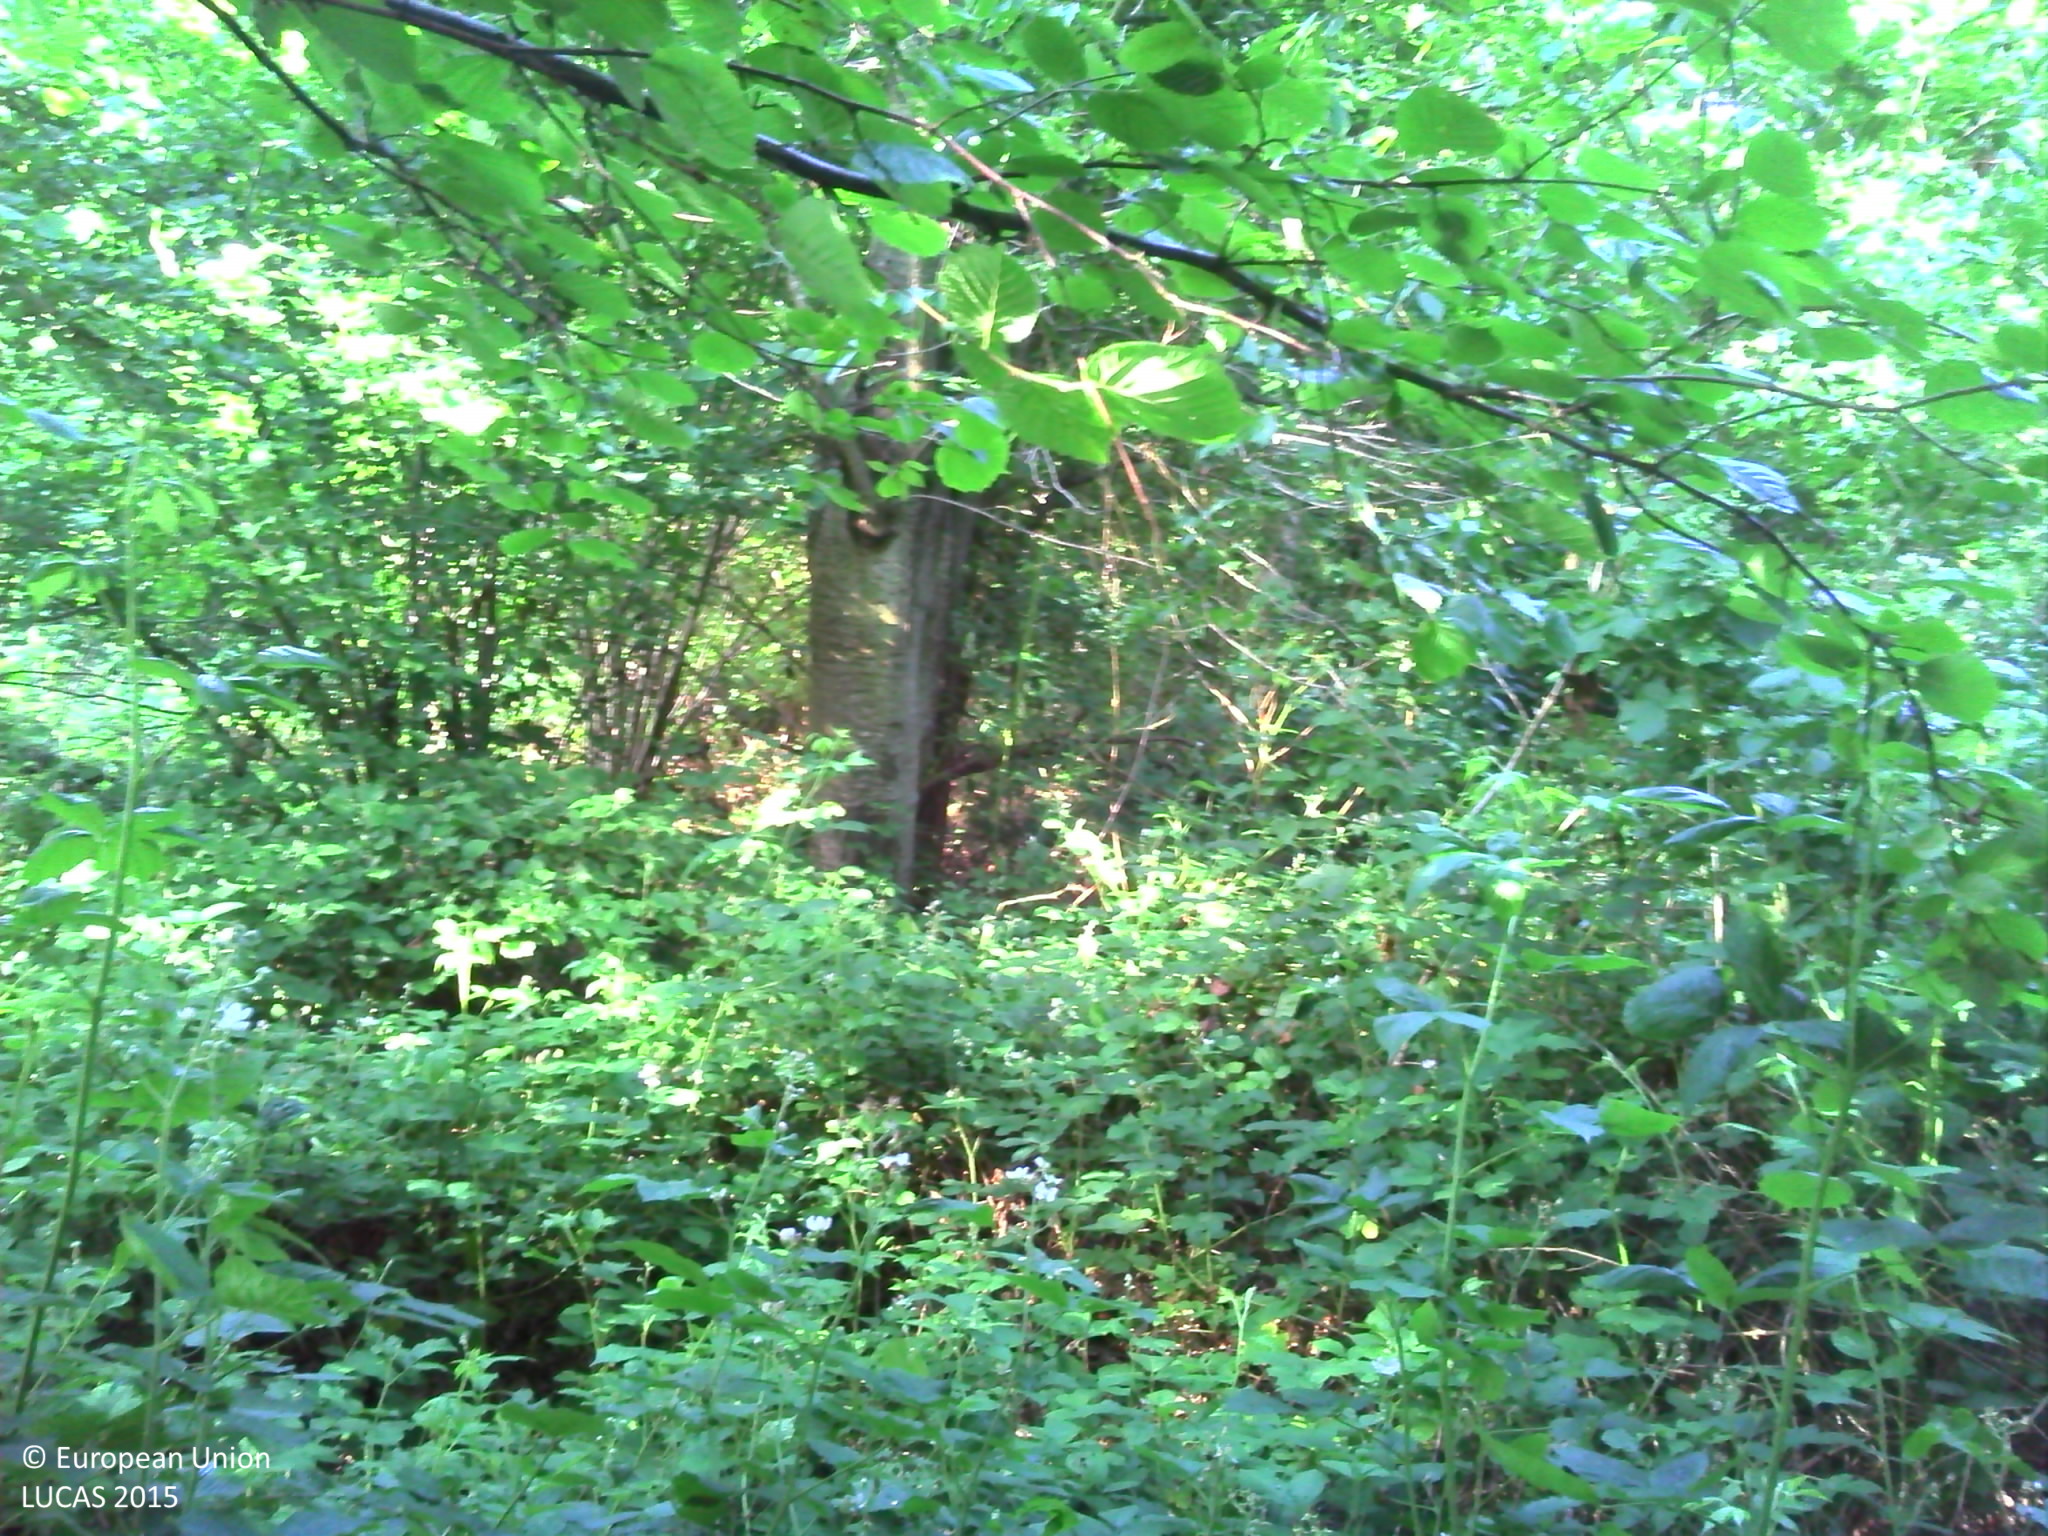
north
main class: Woodland
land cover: Broadleaved woodland
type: mesophytic deciduous forest
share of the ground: > 75 %
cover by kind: broadleaved forest trees 80 %, herbaceous plants 10 %, consolidated bare surface 10 %
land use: Forestry
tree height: > 5 m
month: June
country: FR
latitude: 49.1622
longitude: 1.0510
